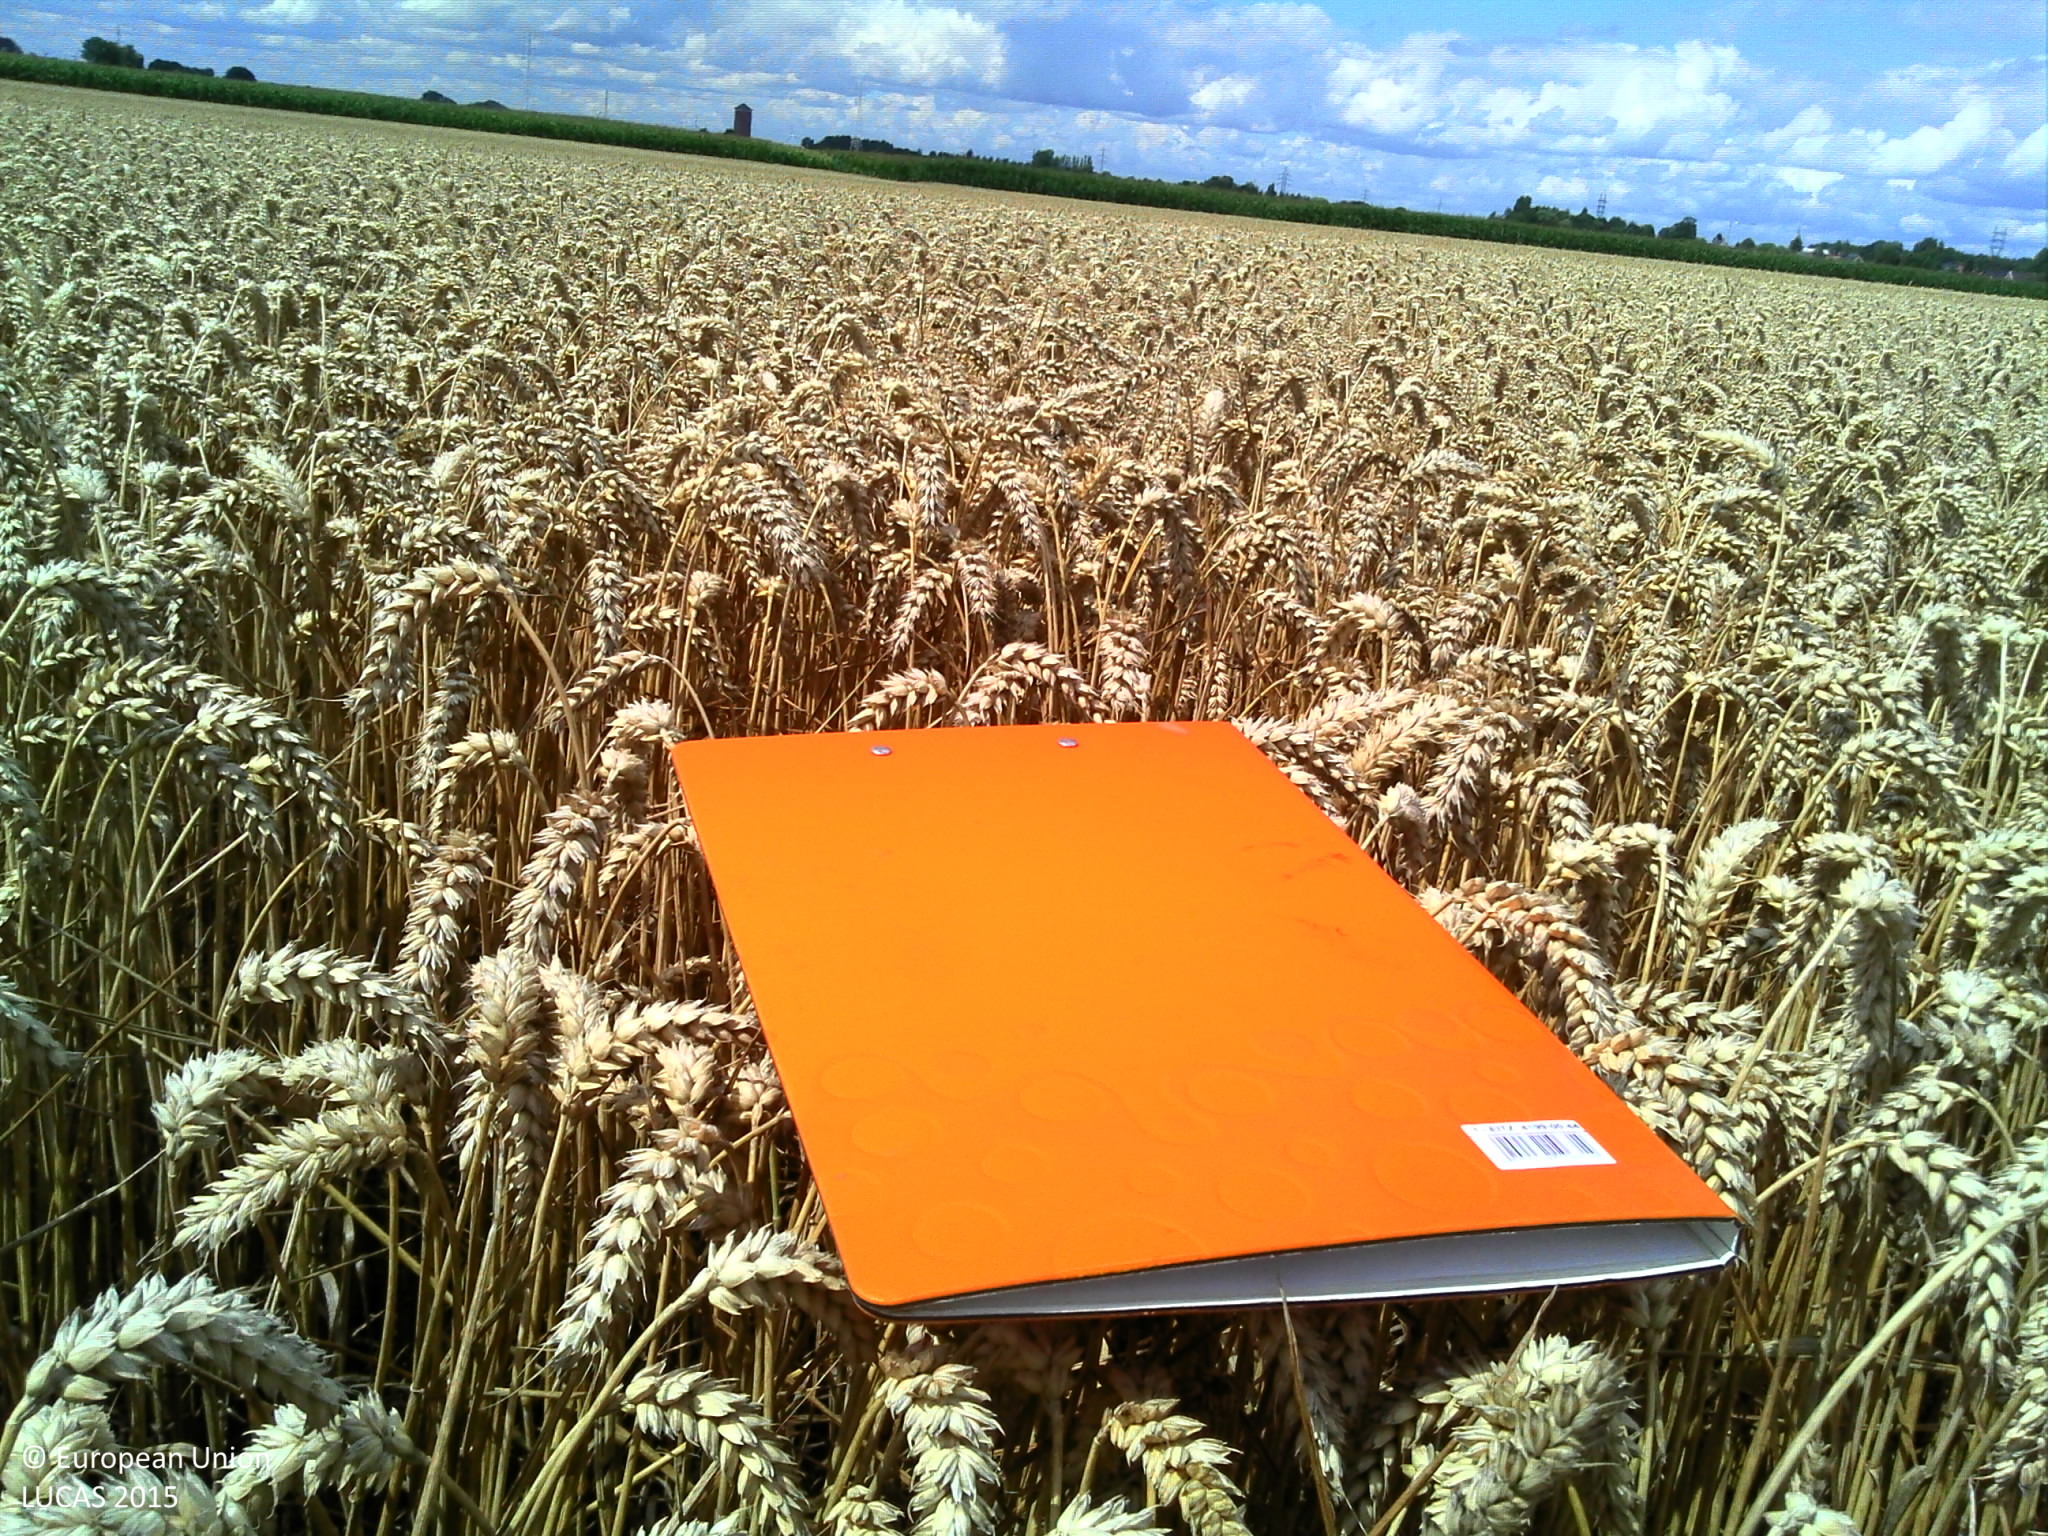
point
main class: Cropland
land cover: Common wheat
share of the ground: > 75 %
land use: Agriculture (excluding fallow land and kitchen gardens)
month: July
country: BE
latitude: 51.0210
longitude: 4.4214
